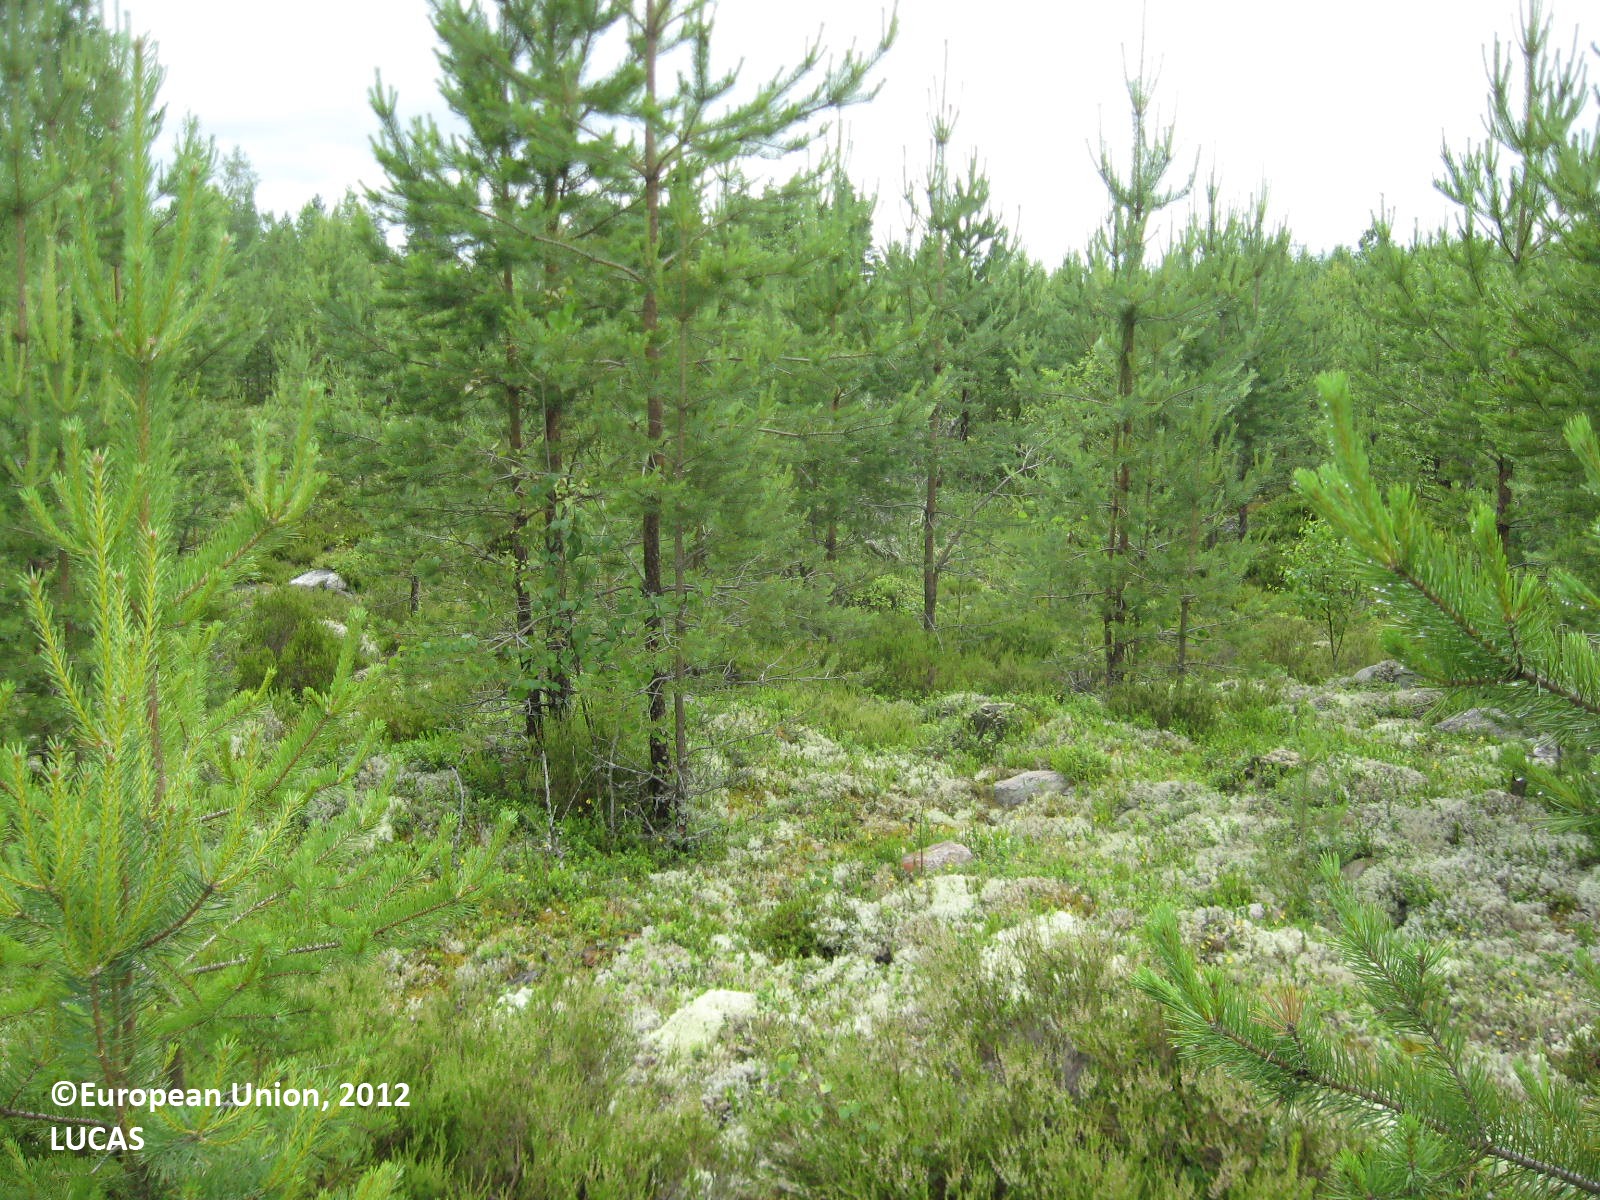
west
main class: Woodland
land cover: Pine dominated coniferous woodland
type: boreal forest
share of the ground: 50 - 75 %
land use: Forestry
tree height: < 5 m
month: July
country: FI
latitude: 62.4566
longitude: 22.4812
